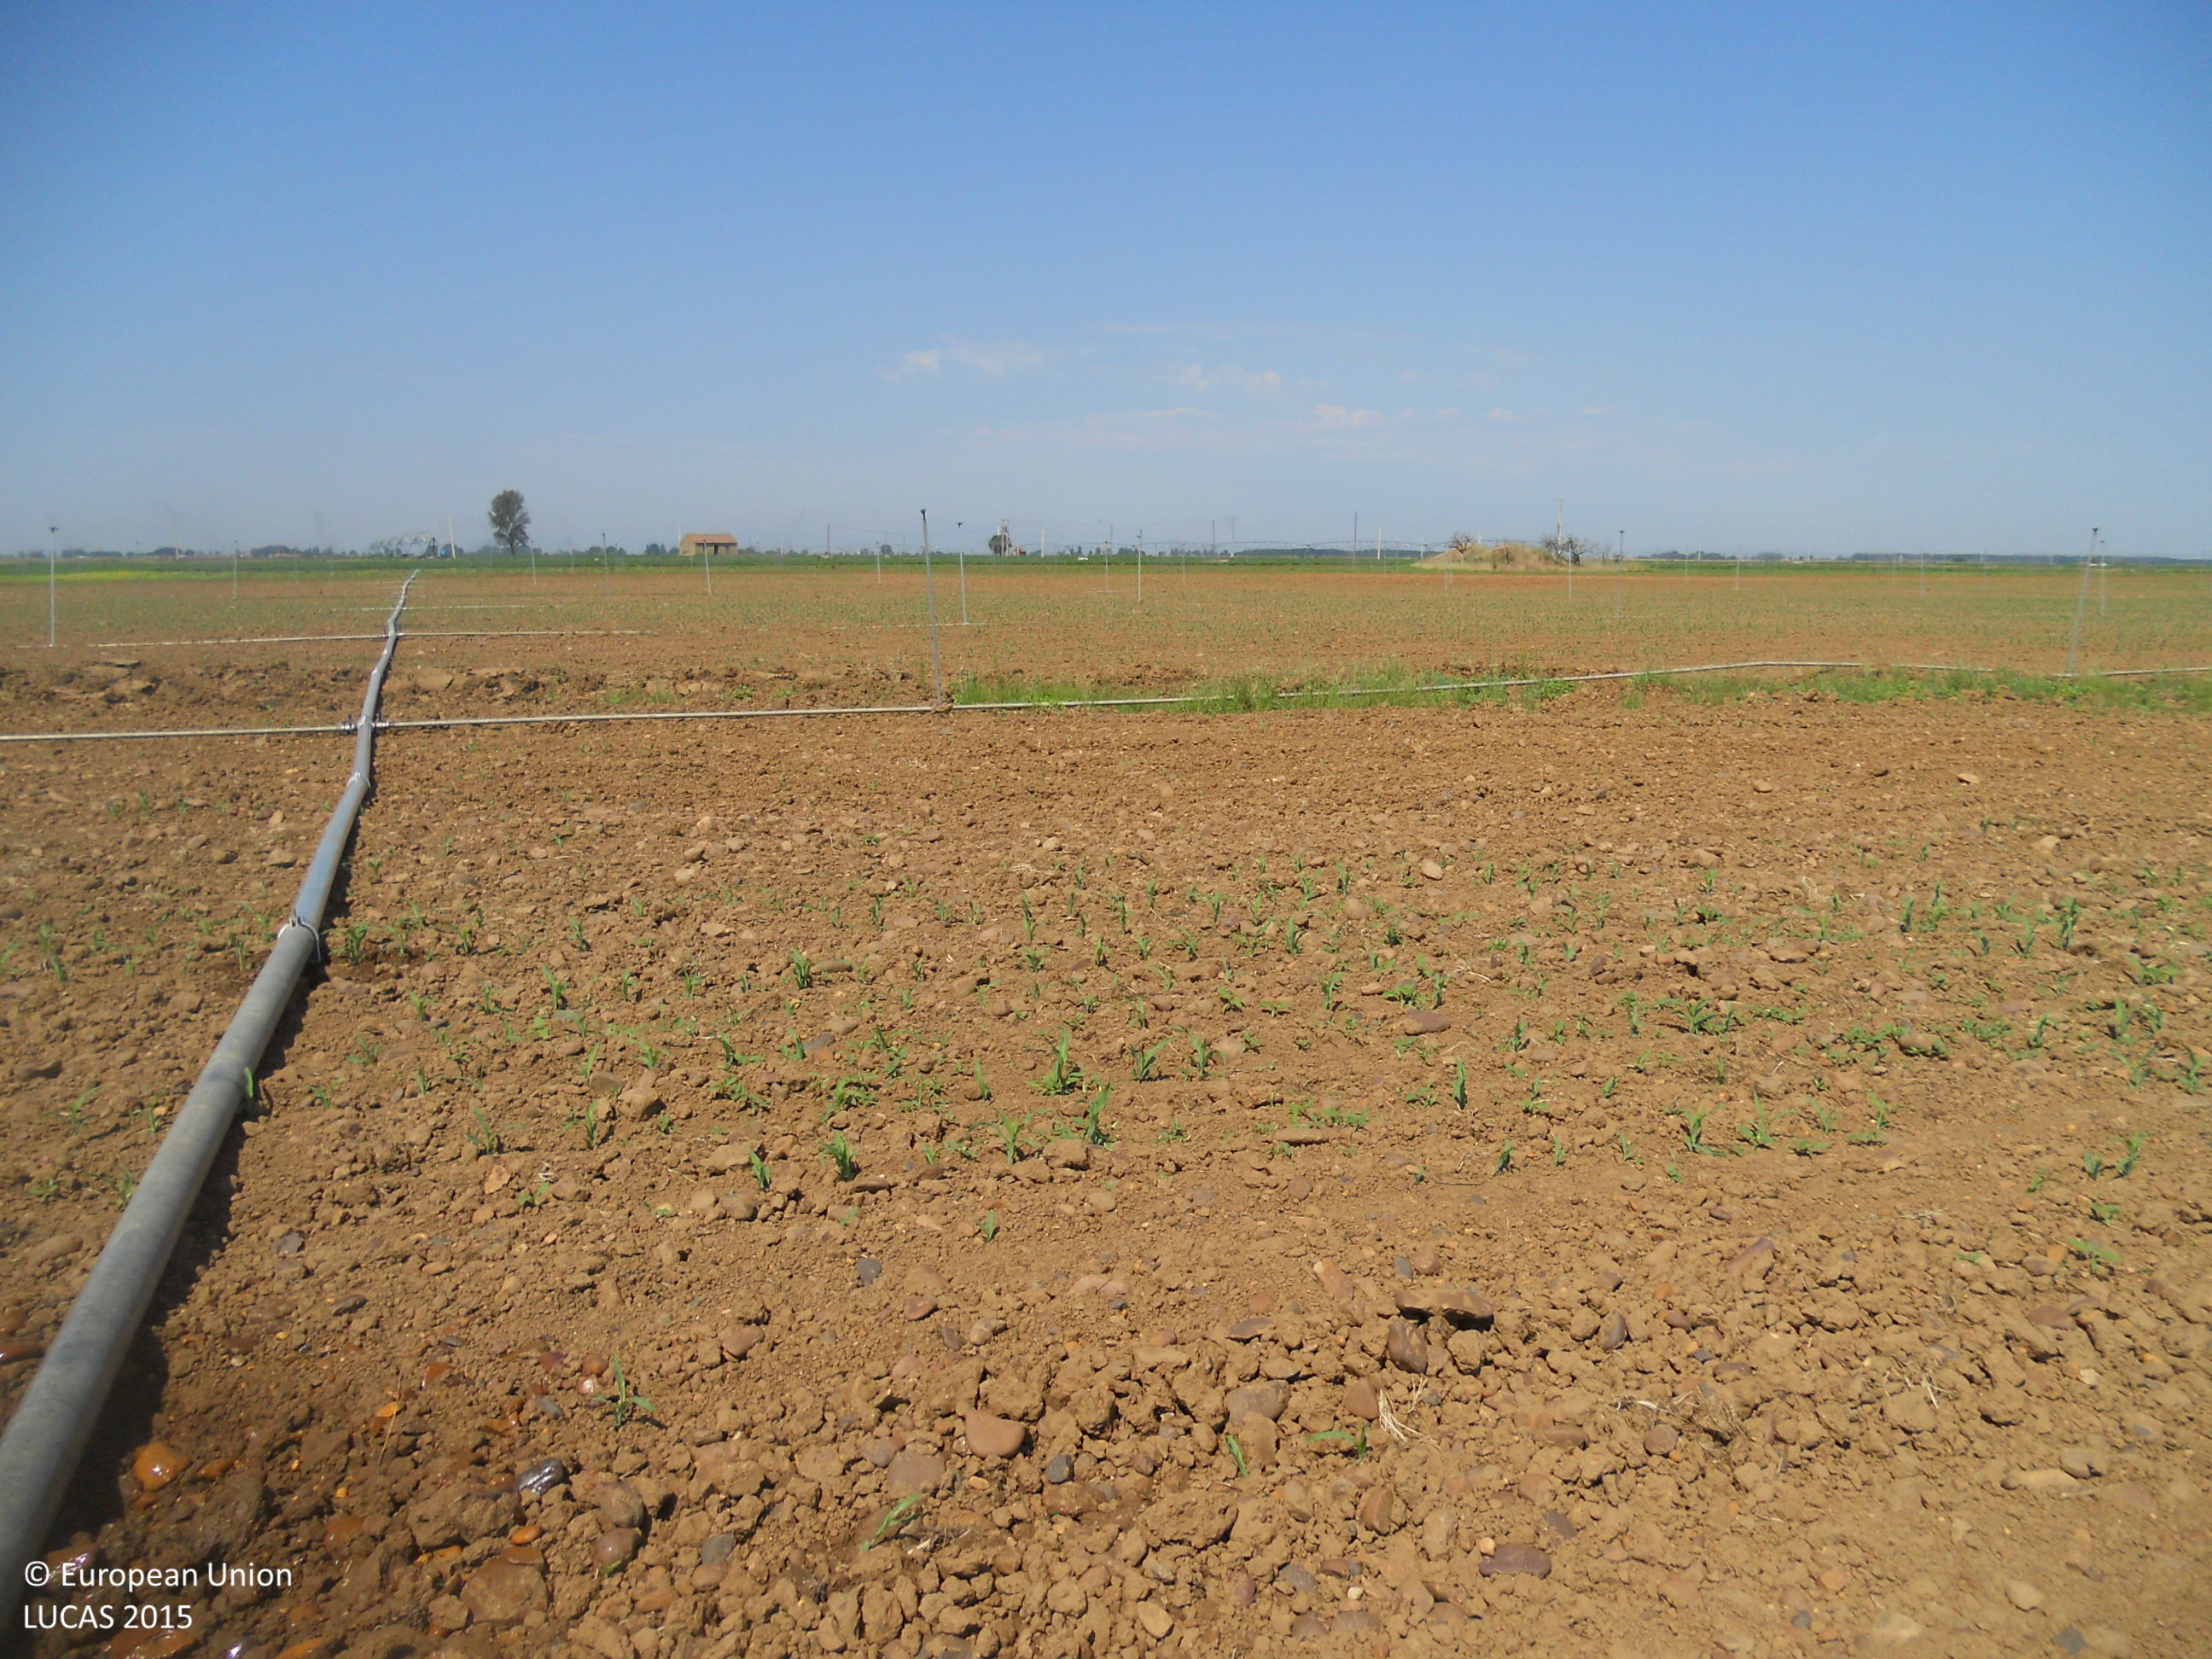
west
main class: Cropland
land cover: Maize
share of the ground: < 10 %
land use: Agriculture (excluding fallow land and kitchen gardens)
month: June
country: ES
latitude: 42.3650
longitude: -5.6504
